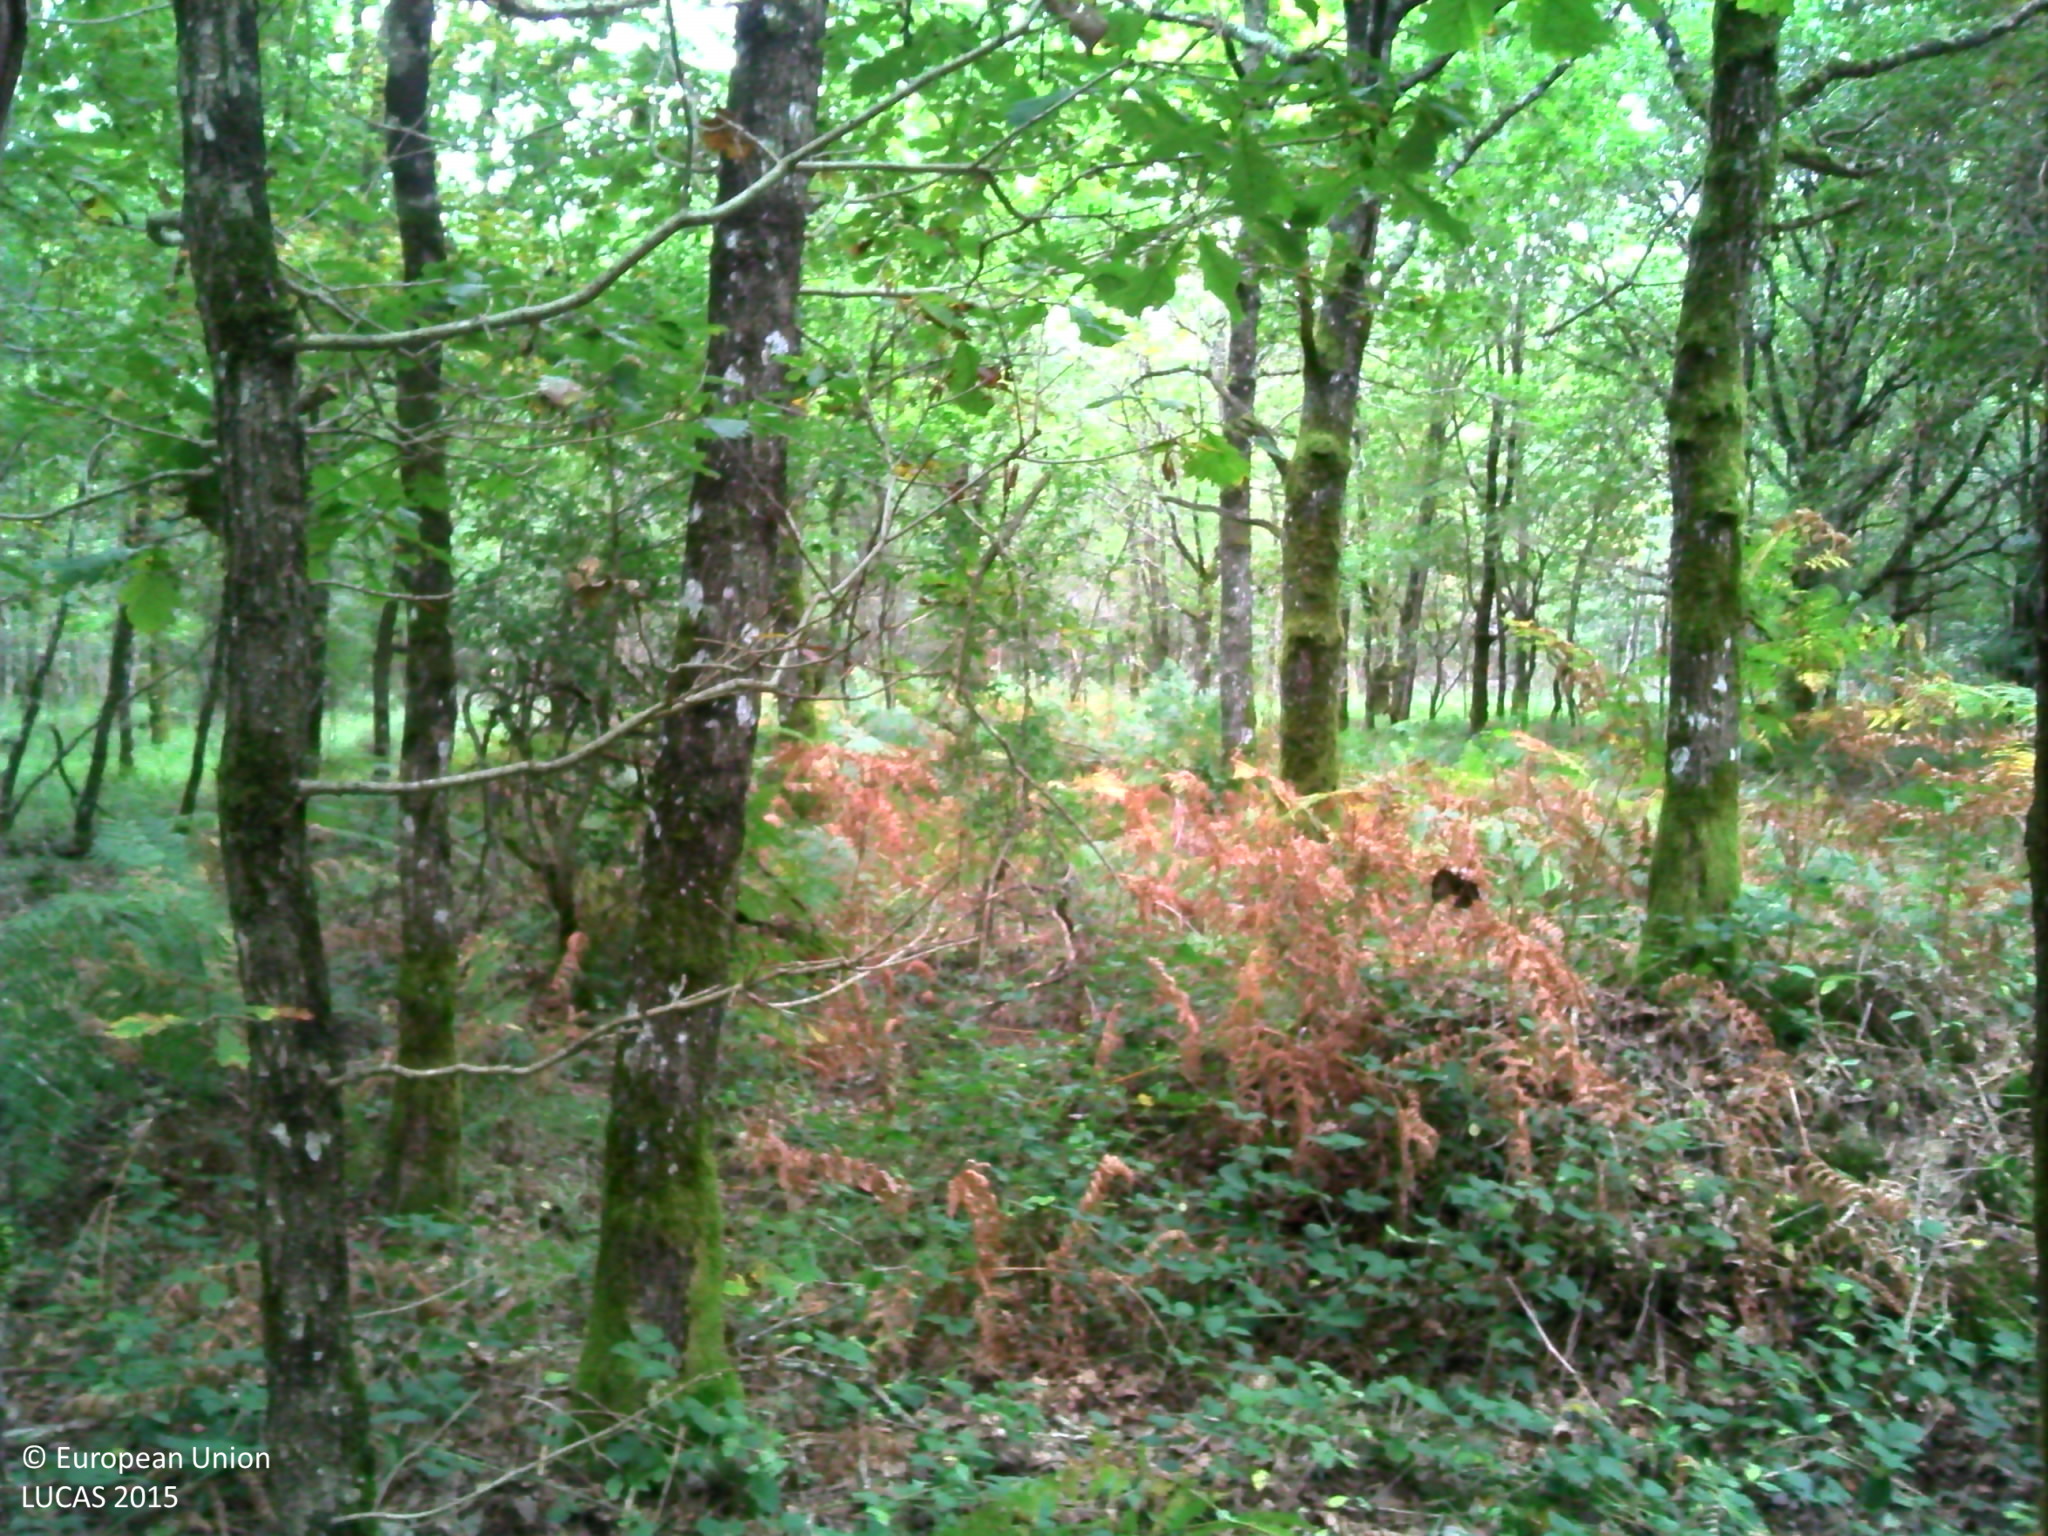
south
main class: Woodland
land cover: Broadleaved woodland
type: mesophytic deciduous forest
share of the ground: > 75 %
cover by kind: broadleaved forest trees 100 %
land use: Forestry
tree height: > 5 m
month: August
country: FR
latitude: 47.2387
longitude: 2.1575
